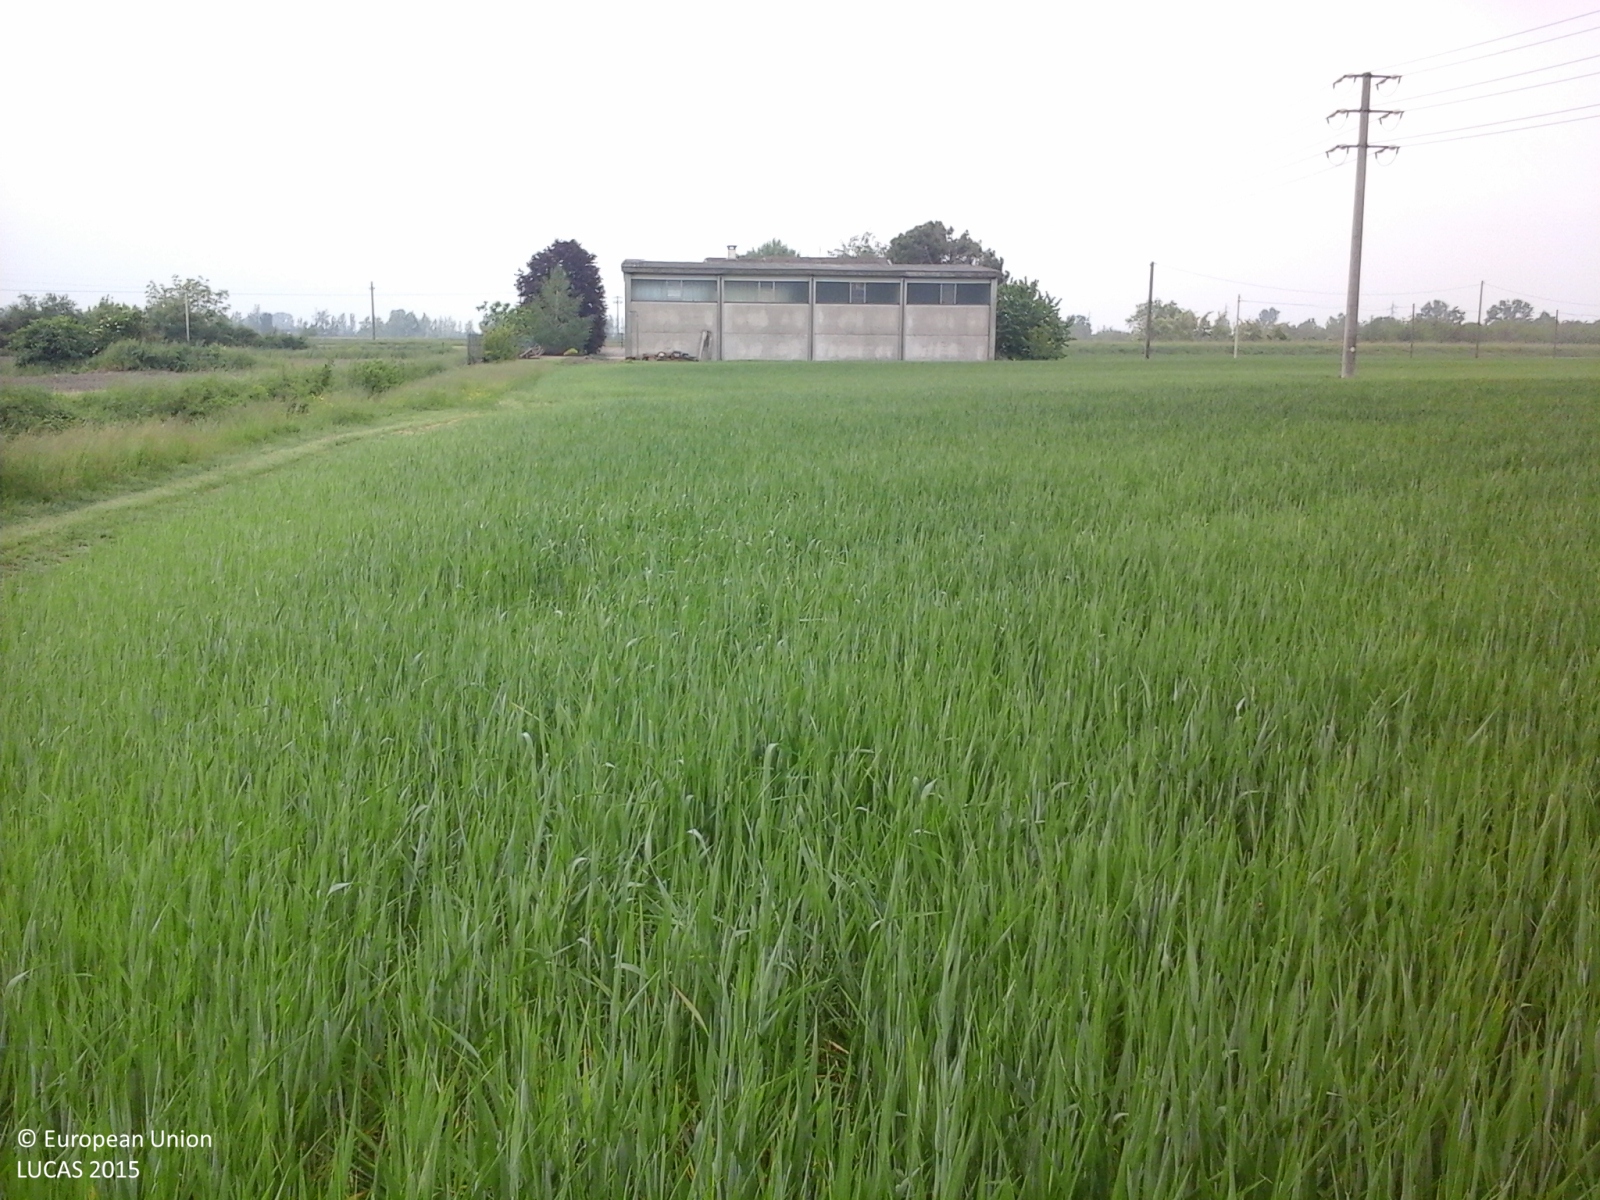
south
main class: Cropland
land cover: Common wheat
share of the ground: > 75 %
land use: Agriculture (excluding fallow land and kitchen gardens)
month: May
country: IT
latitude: 44.9982
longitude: 10.5697
